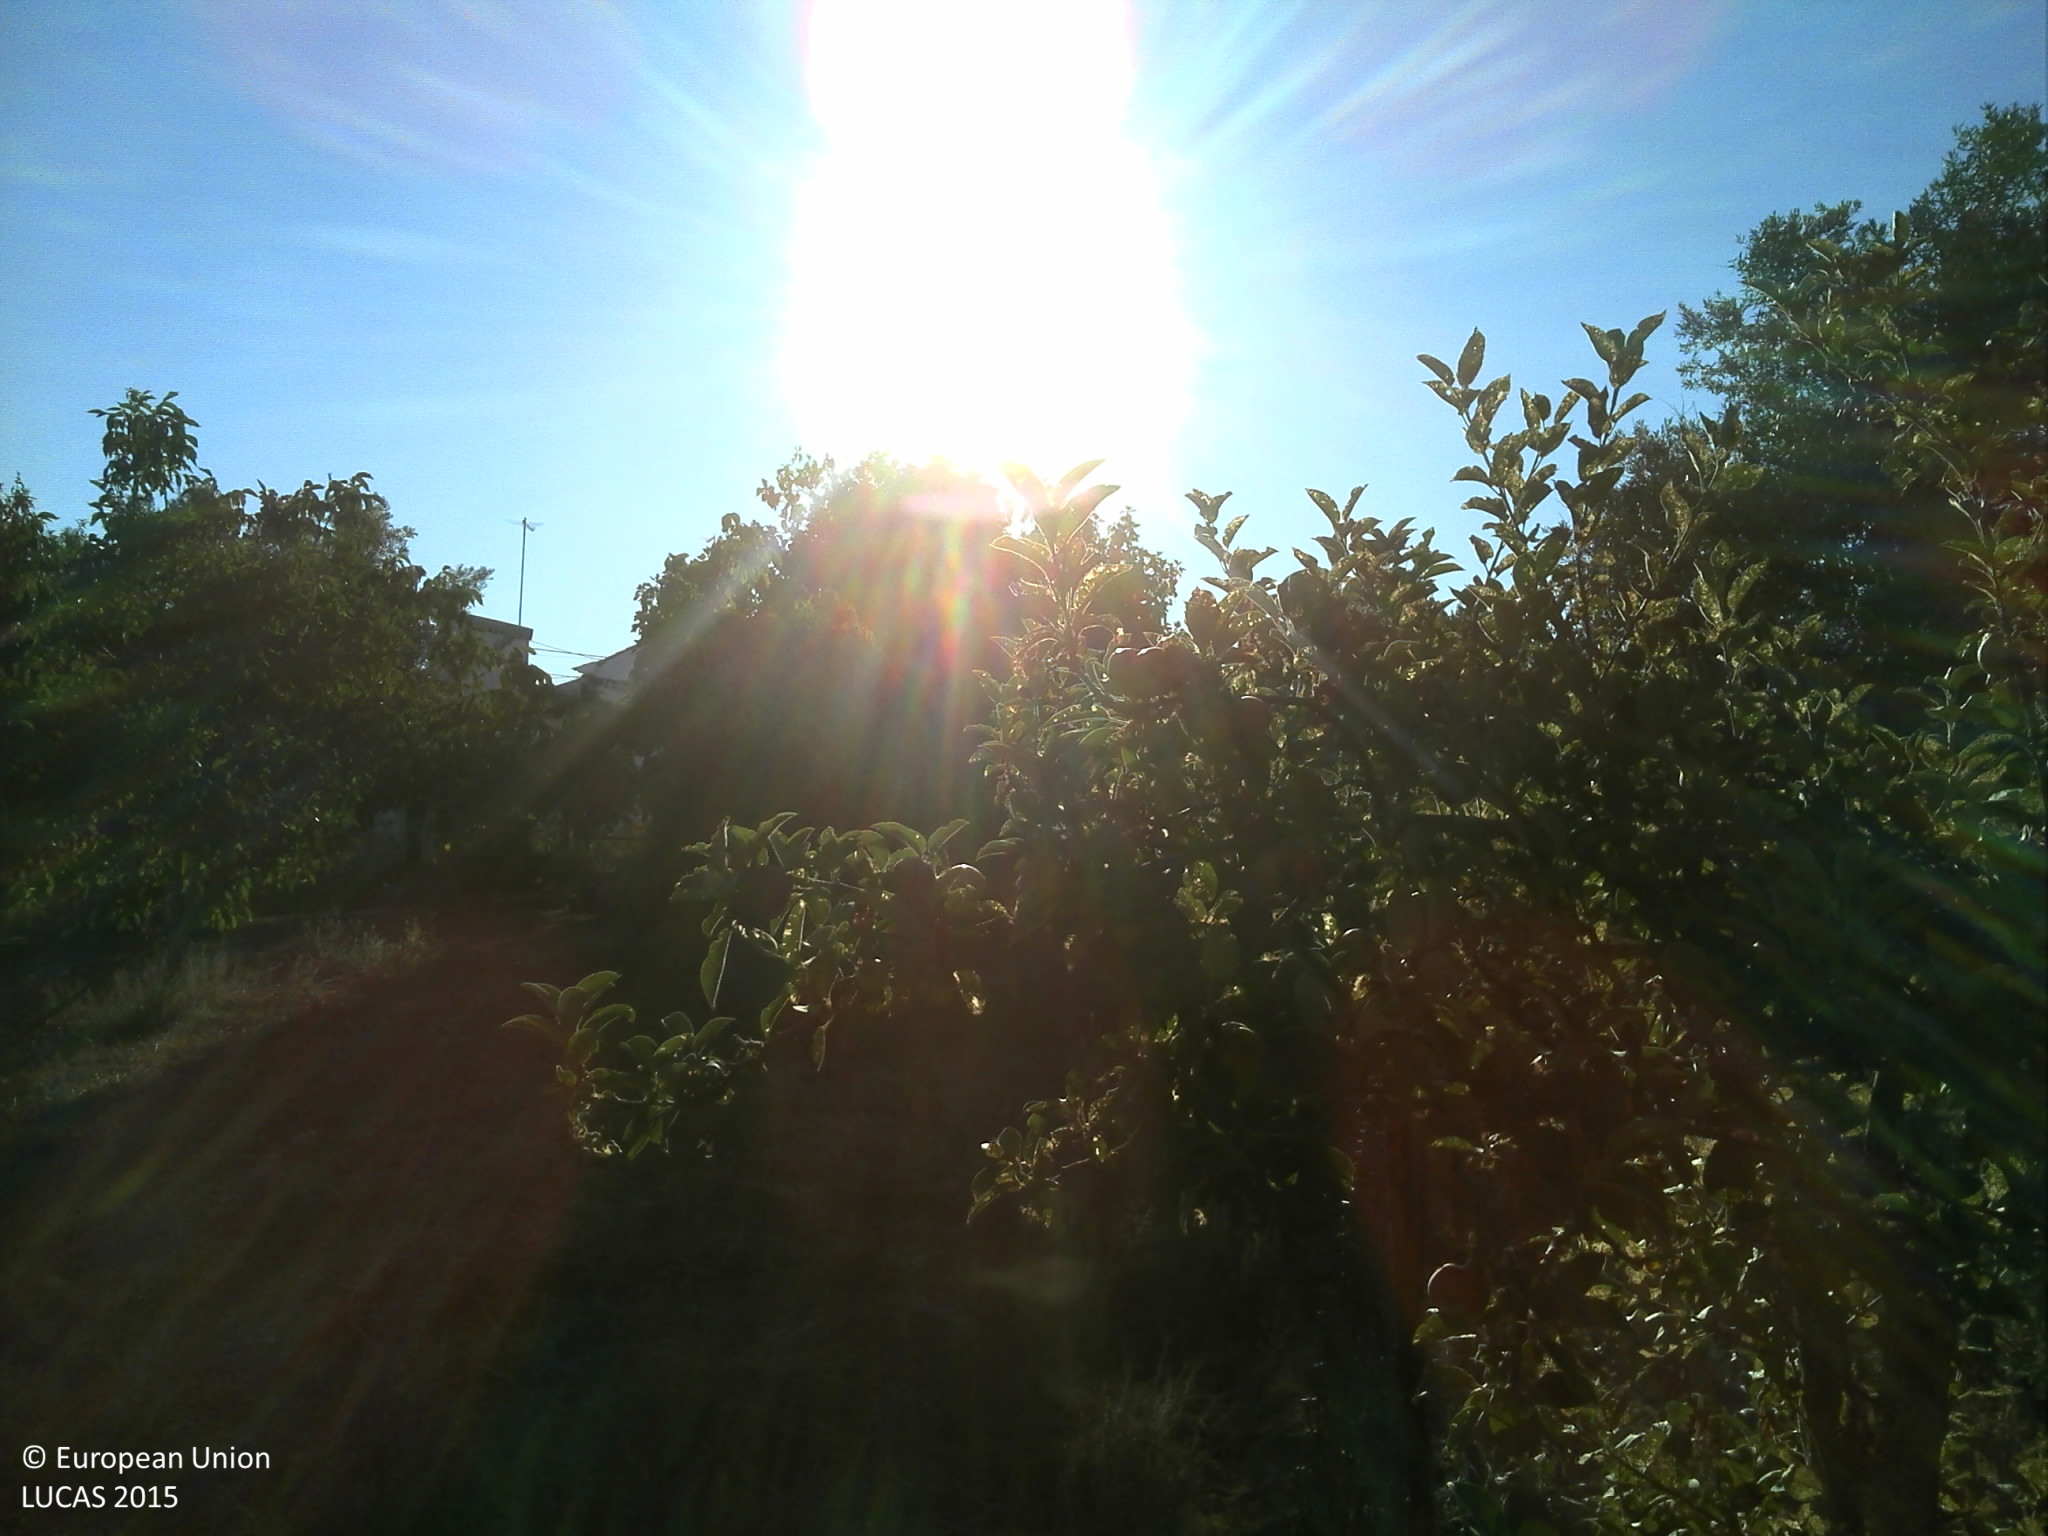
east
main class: Shrubland
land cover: Shrubland without tree cover
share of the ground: 50 - 75 %
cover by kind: unconsolidated bare surface 50 %, shrubs 25 %, herbaceous plants 25 %
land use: Fallow land
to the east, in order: Shrubland without tree cover; Artificial constructions in urban areas
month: July
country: PT
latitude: 38.8929
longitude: -7.5501
